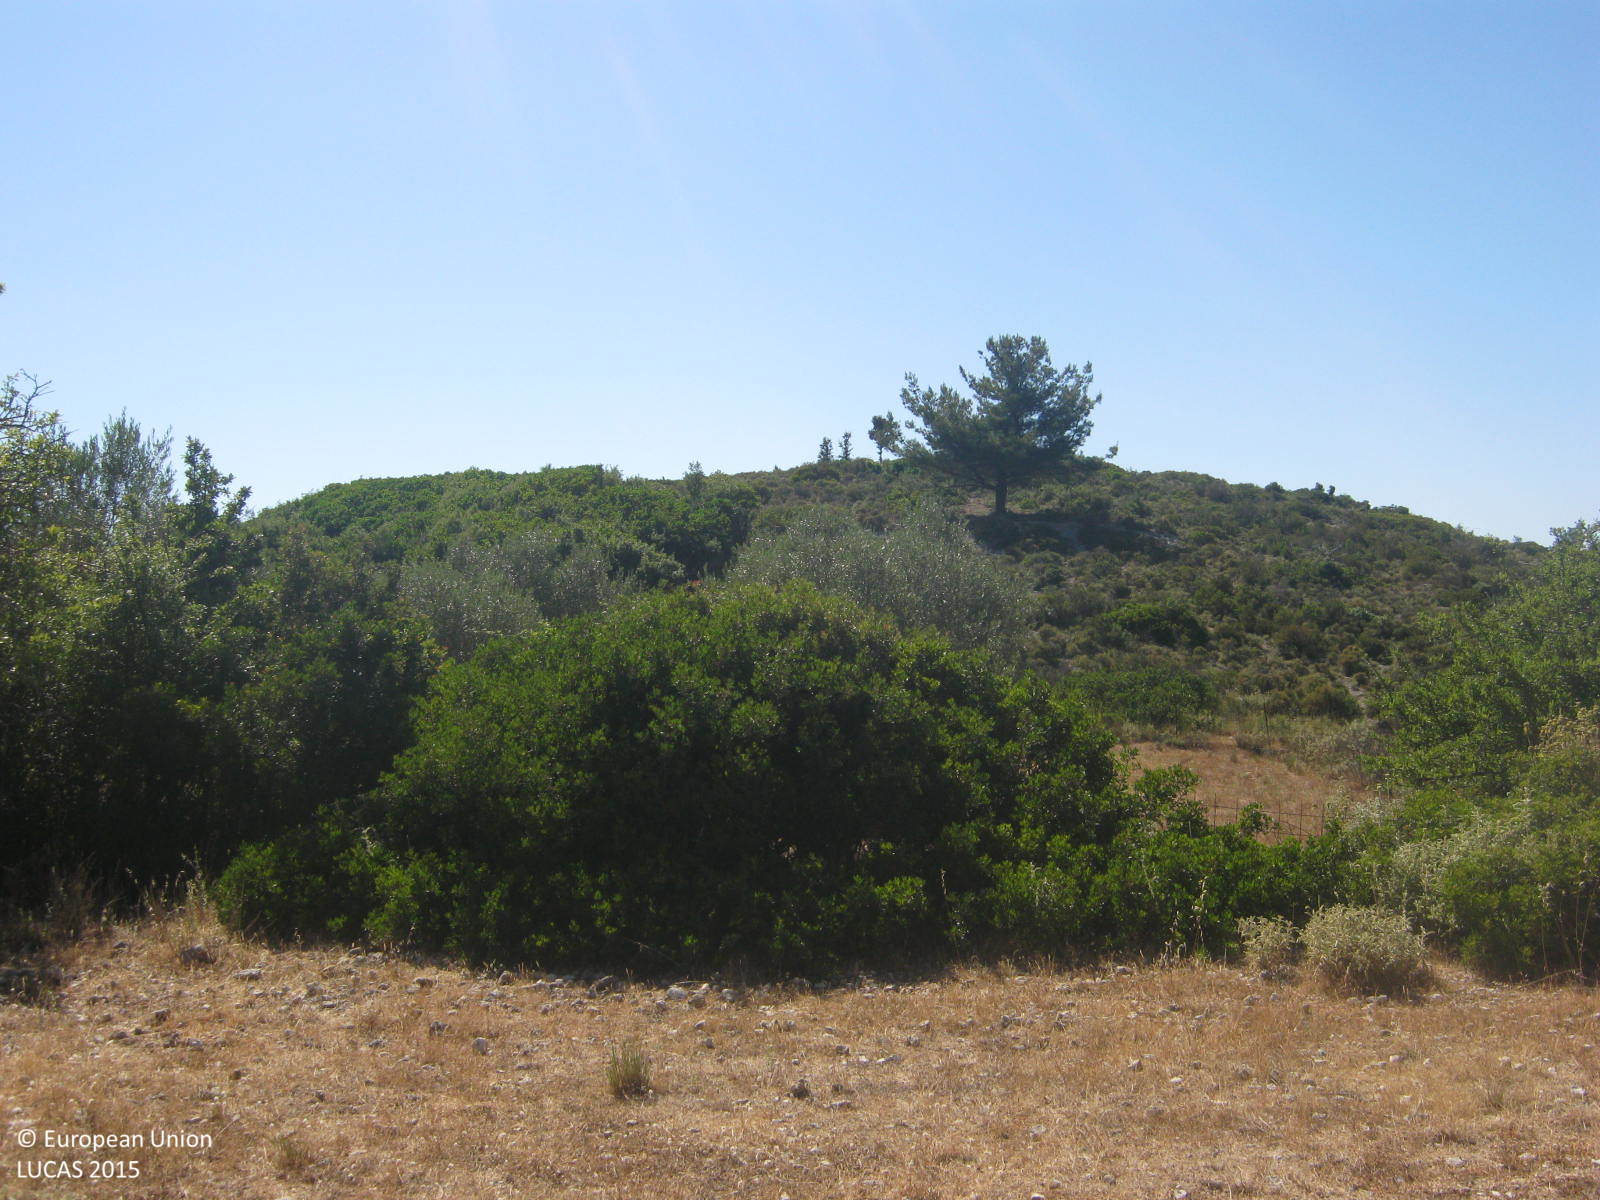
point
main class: Shrubland
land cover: Shrubland with sparse tree cover
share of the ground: 50 - 75 %
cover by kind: shrubs 60 %, consolidated bare surface 35 %, coniferous forest trees 5 %
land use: Semi-natural and natural areas not in use
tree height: < 5 m
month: June
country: GR
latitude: 38.6544
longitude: 20.5724
